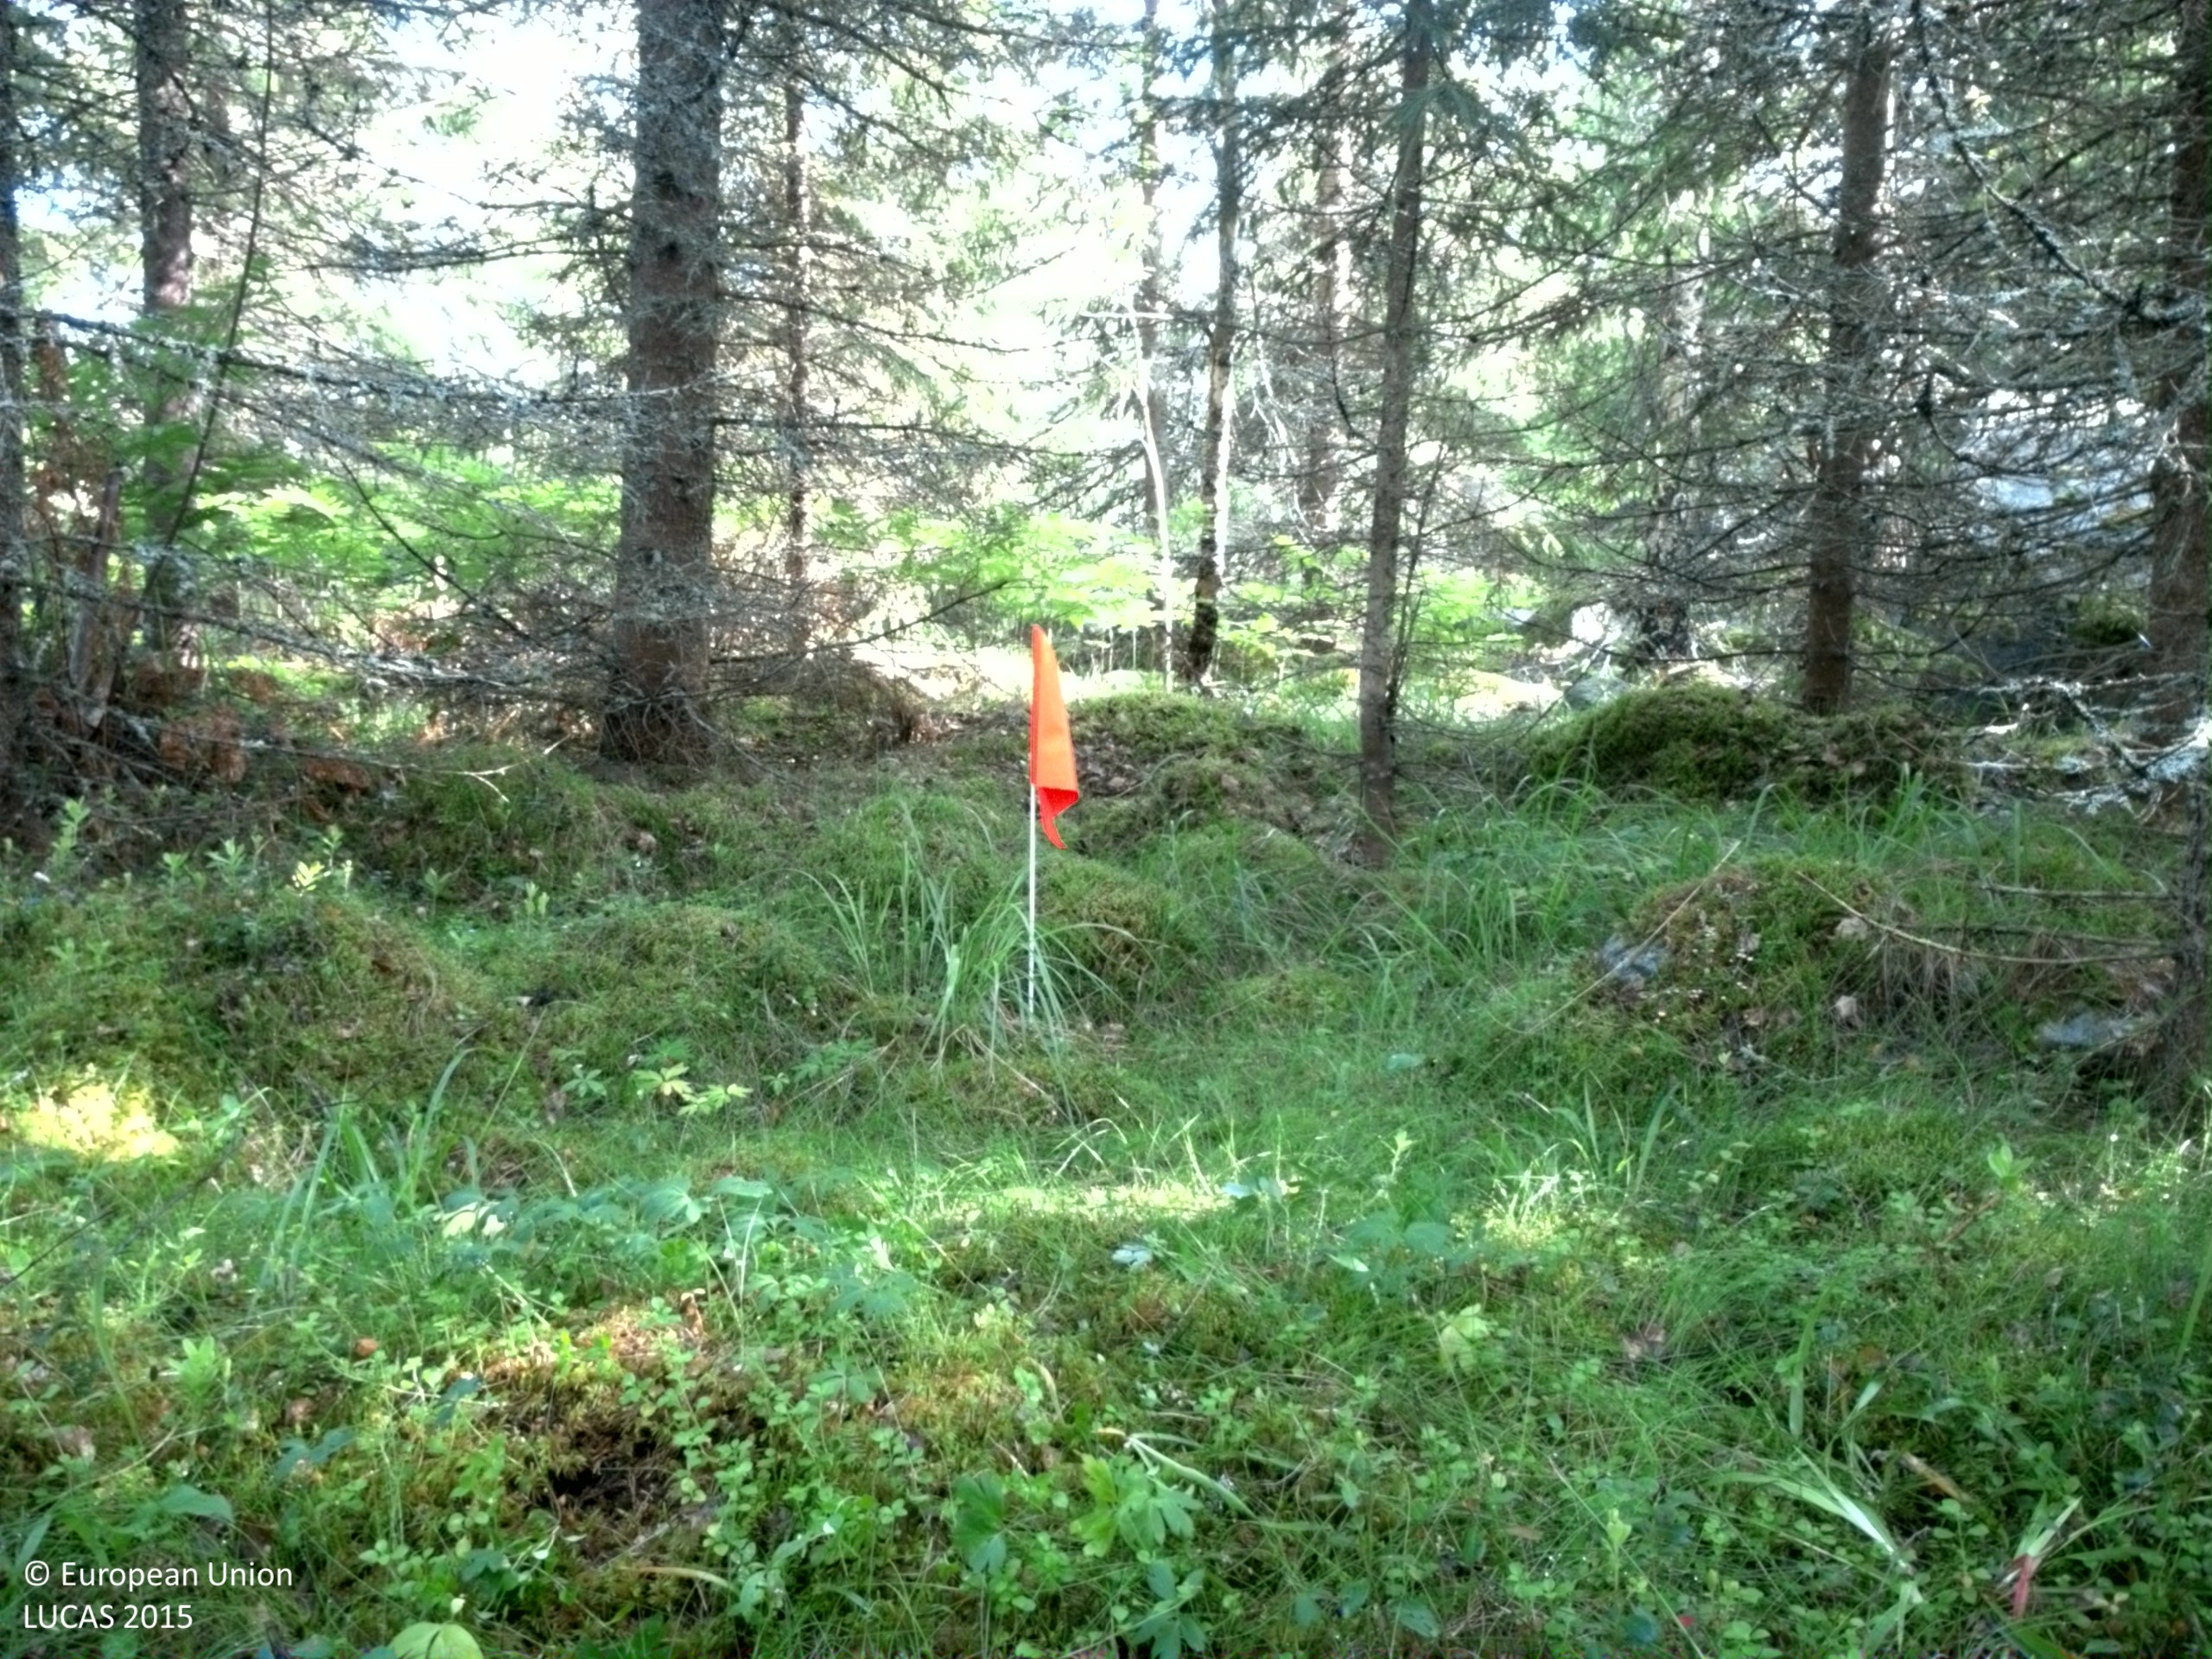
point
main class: Woodland
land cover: Spruce dominated coniferous woodland
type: boreal forest
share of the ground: > 75 %
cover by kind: coniferous forest trees 75 %, shrubs 10 %, lichens and mosses 10 %, herbaceous plants 5 %
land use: Forestry
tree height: > 5 m
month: June
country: SE
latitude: 60.3704
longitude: 17.6624
